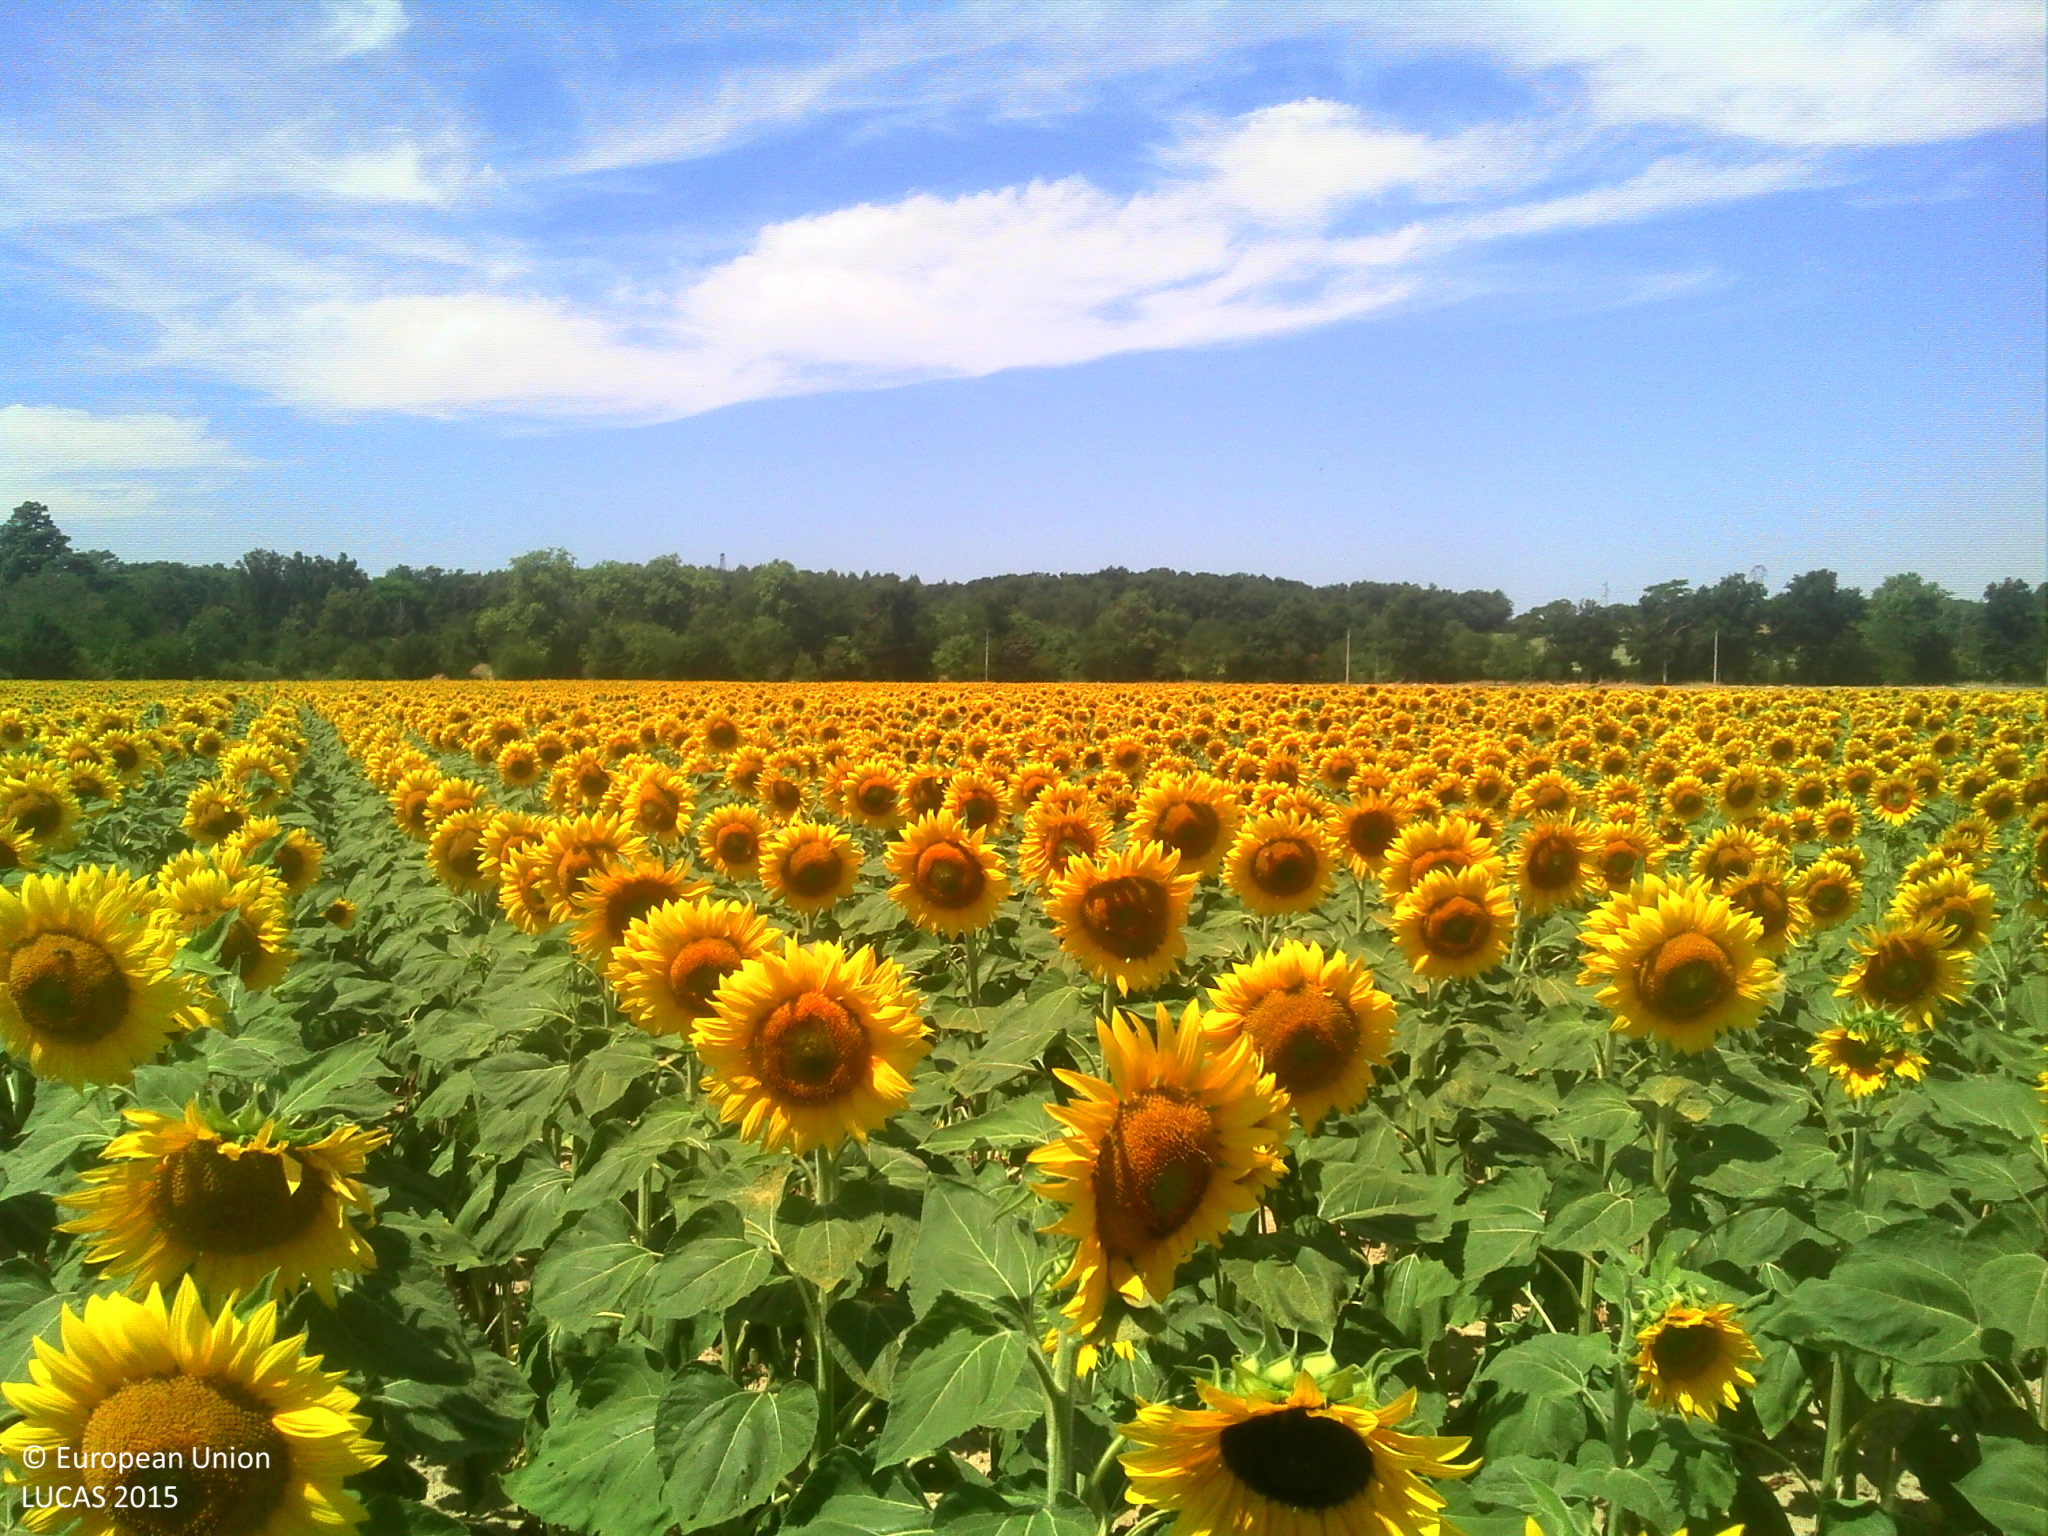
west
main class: Cropland
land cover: Sunflower
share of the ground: > 75 %
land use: Agriculture (excluding fallow land and kitchen gardens)
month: July
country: FR
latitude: 43.3944
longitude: 1.3984
